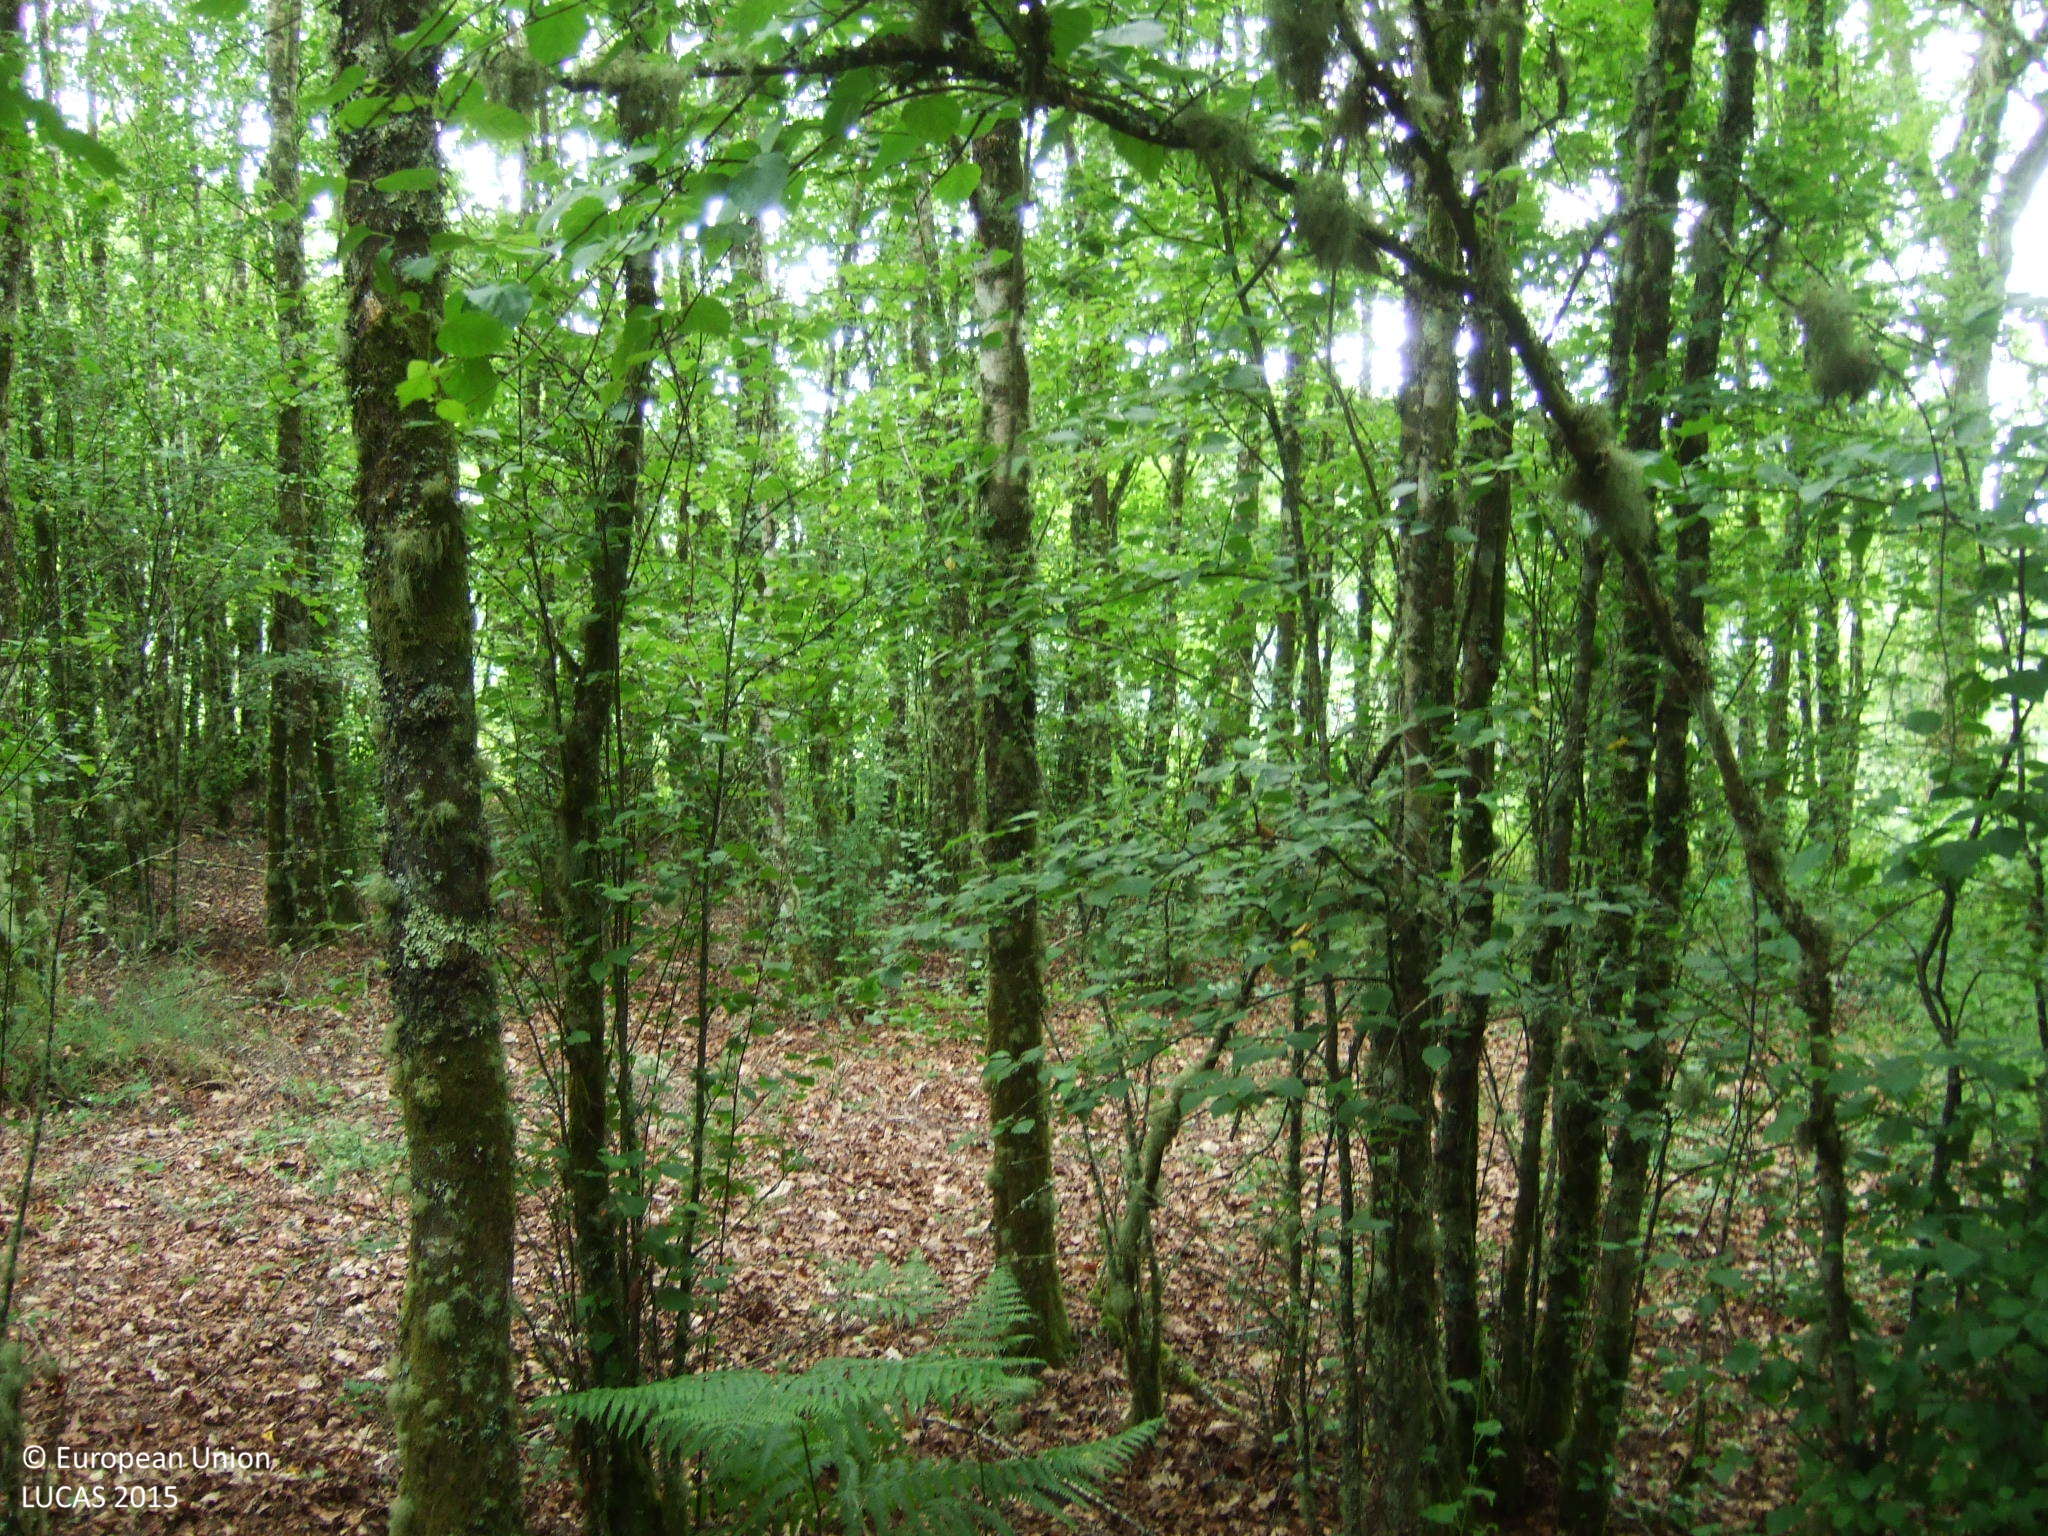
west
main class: Woodland
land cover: Broadleaved woodland
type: acidophilous oak and oak-birch forest
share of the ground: 50 - 75 %
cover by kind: broadleaved forest trees 70 %, shrubs 15 %, herbaceous plants 15 %
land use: Forestry
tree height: > 5 m
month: June
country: ES
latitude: 43.3726
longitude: -7.7733
